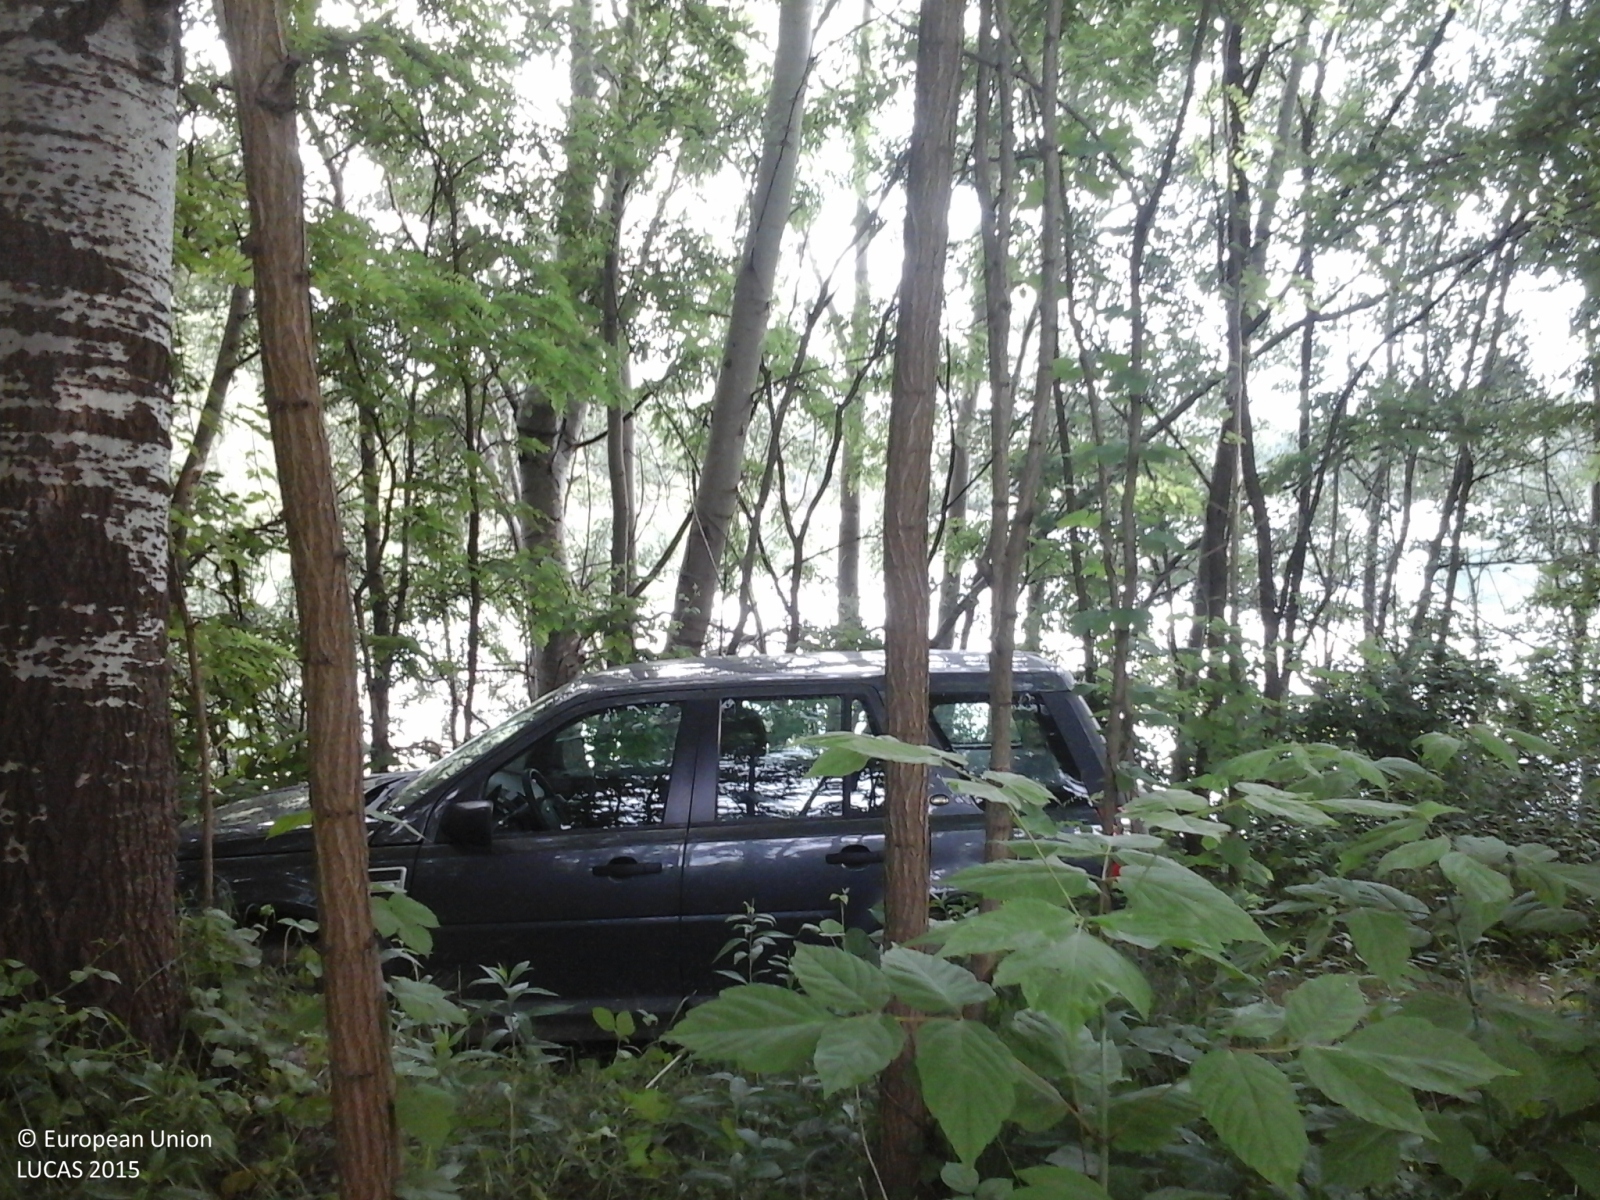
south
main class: Grassland
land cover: Grassland with sparse tree/shrub cover
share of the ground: > 75 %
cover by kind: herbaceous plants 85 %, shrubs 10 %, broadleaved forest trees 5 %
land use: Semi-natural and natural areas not in use
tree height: < 5 m
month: May
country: IT
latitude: 44.9021
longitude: 7.6867
